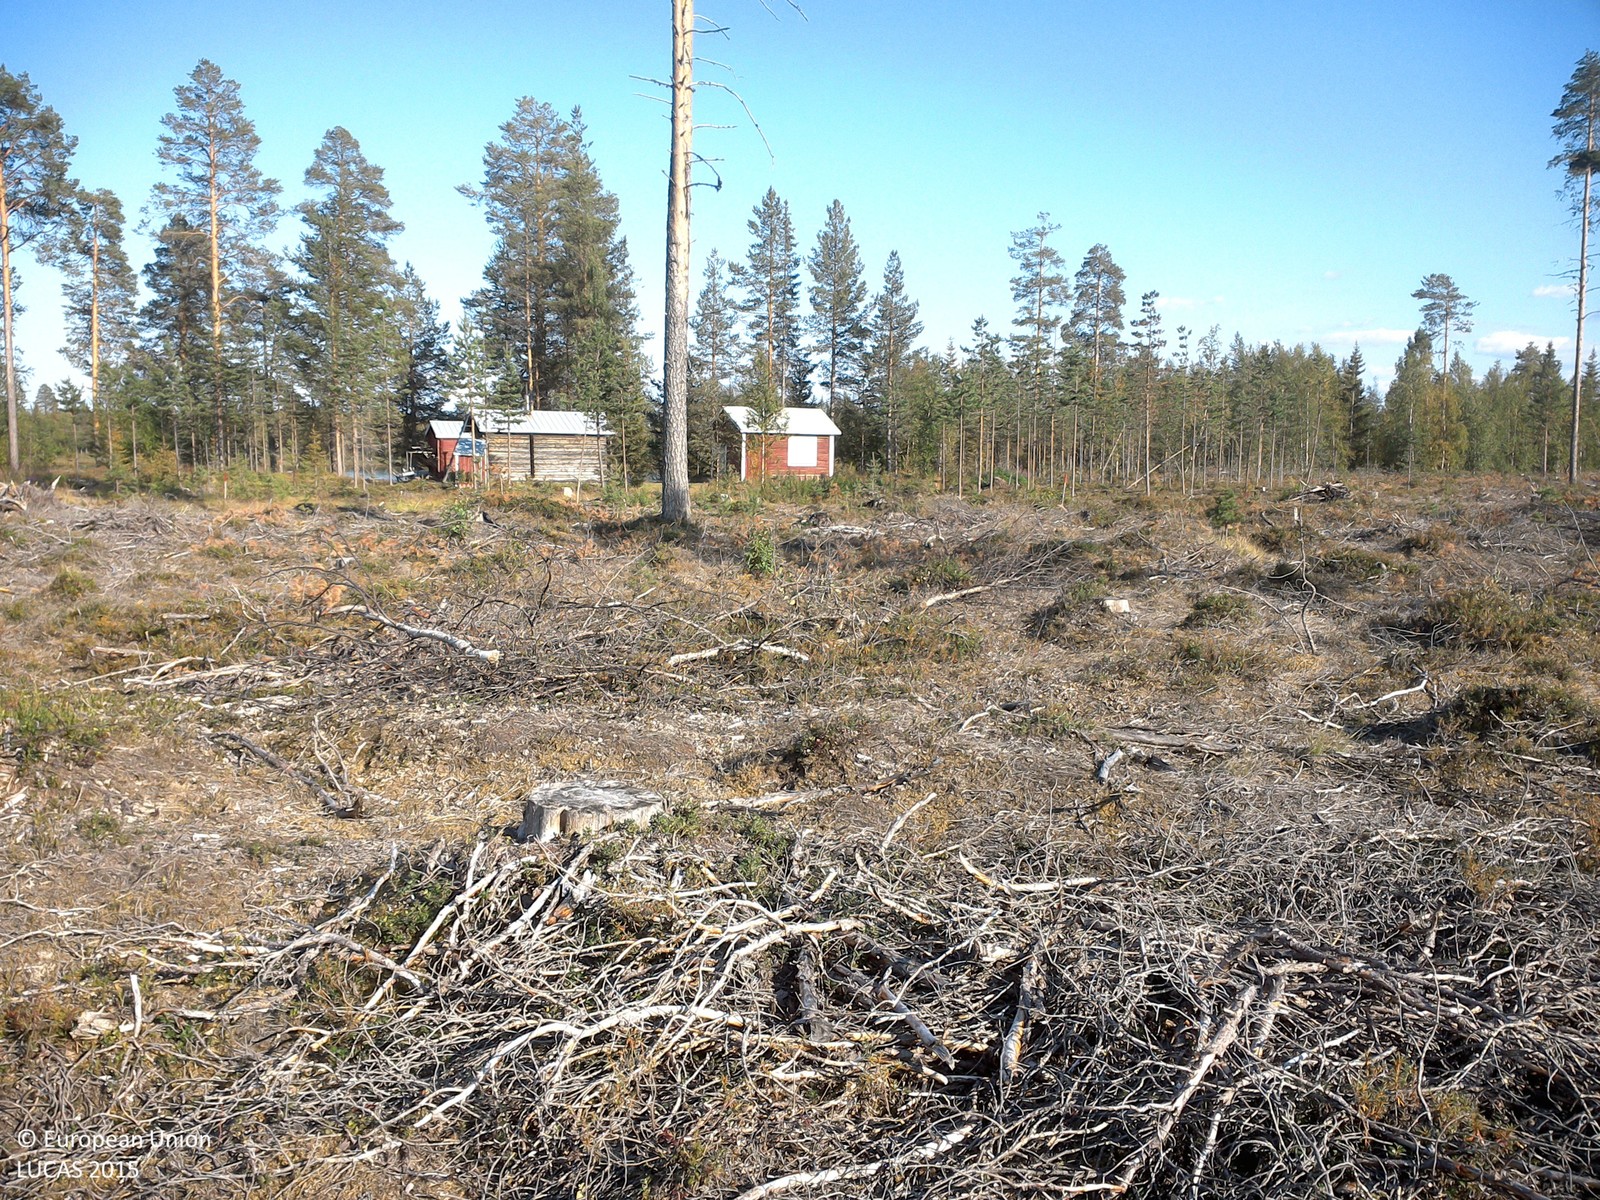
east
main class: Shrubland
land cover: Shrubland with sparse tree cover
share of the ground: 25 - 50 %
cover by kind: lichens and mosses 50 %, shrubs 30 %, unconsolidated bare surface 15 %, broadleaved forest trees 5 %
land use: Forestry
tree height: < 5 m
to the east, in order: Shrubland with sparse tree cover; Tracks; Pine dominated coniferous woodland; Tracks; Artificial constructions in urban areas; Pine dominated mixed woodland; Sand; Inland fresh running water
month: August
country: SE
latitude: 67.1070
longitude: 22.6113
